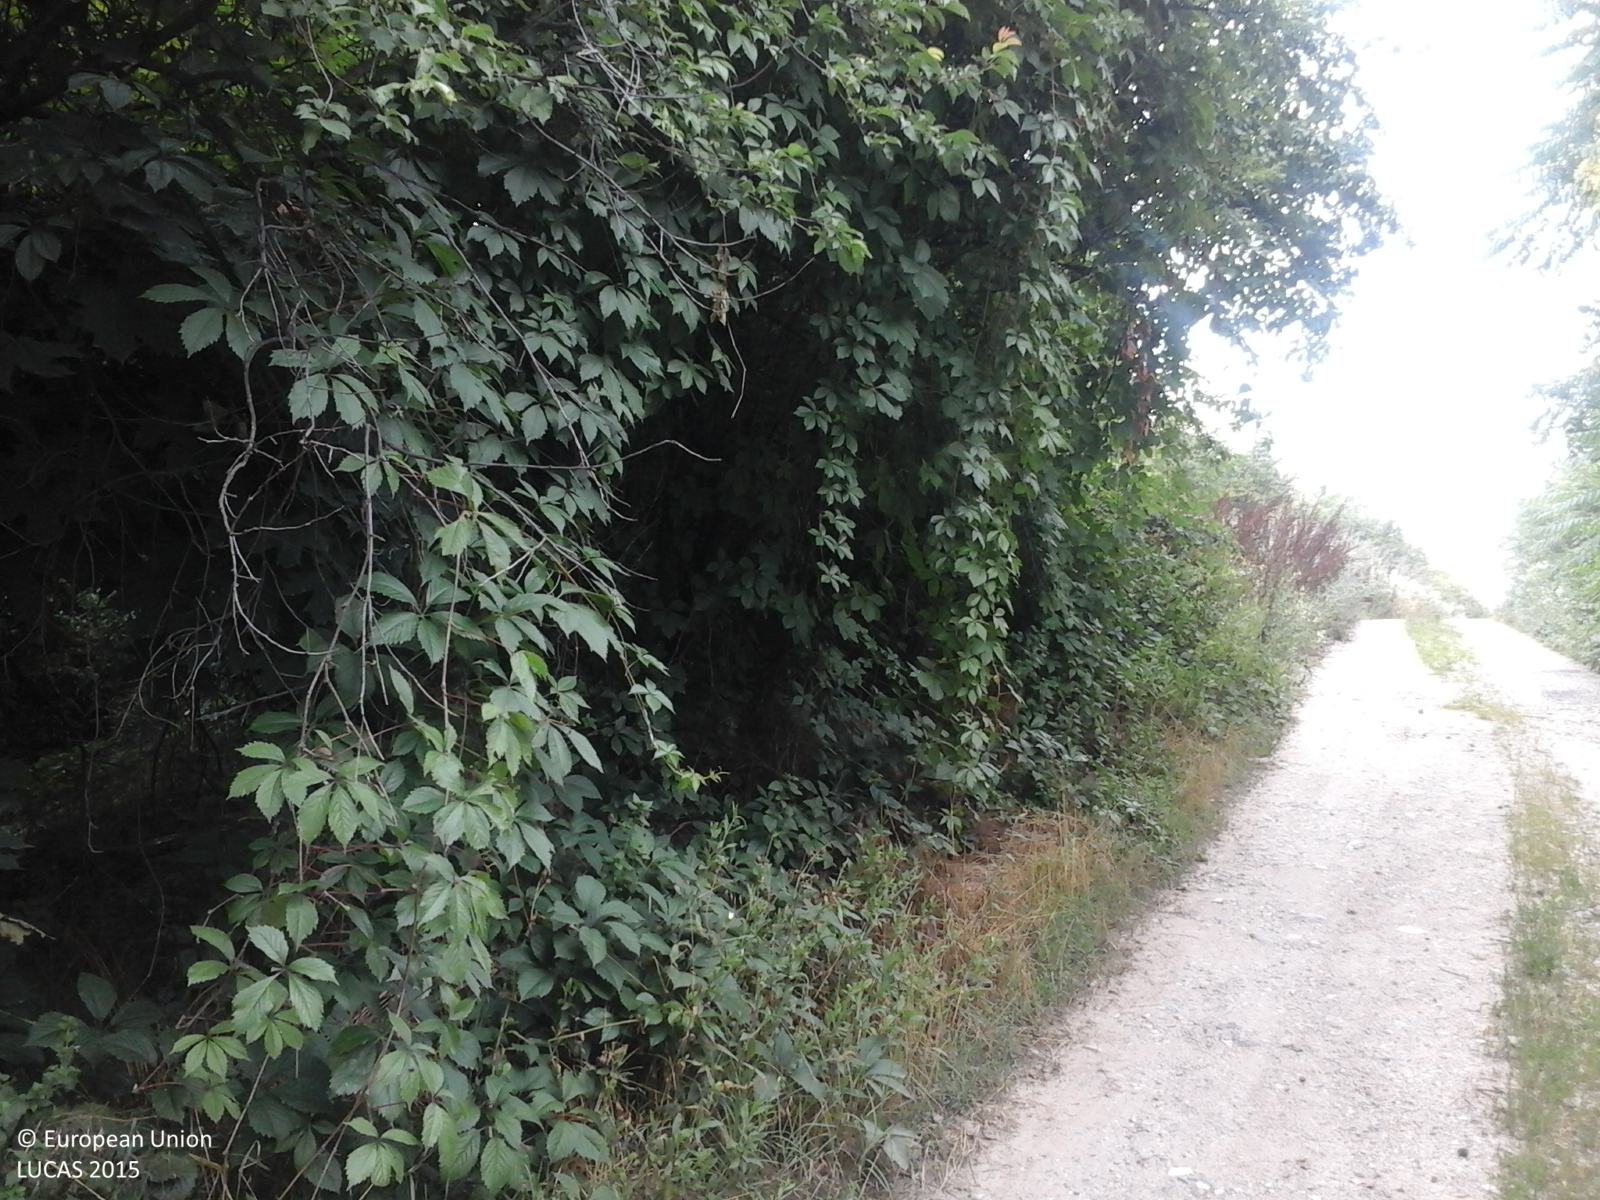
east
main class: Woodland
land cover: Broadleaved woodland
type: thermophilous deciduous forest
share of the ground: > 75 %
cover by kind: broadleaved forest trees 75 %, shrubs 25 %
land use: Forestry
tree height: > 5 m
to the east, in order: Broadleaved woodland; Shruby margins; Tracks; Shruby margins; Broadleaved woodland; Tracks; Broadleaved woodland; Artificial constructions in urban areas
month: June
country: RO
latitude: 44.4966
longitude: 25.9868
